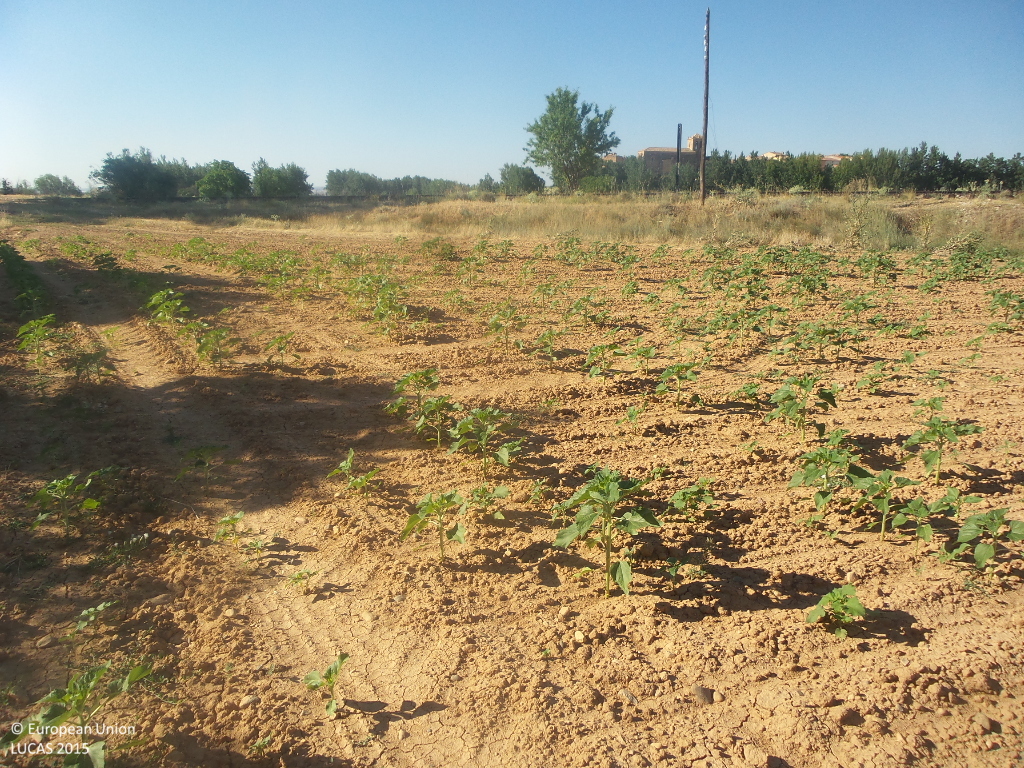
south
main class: Cropland
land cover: Sunflower
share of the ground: < 10 %
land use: Agriculture (excluding fallow land and kitchen gardens)
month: July
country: ES
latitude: 41.3703
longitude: -2.1655
